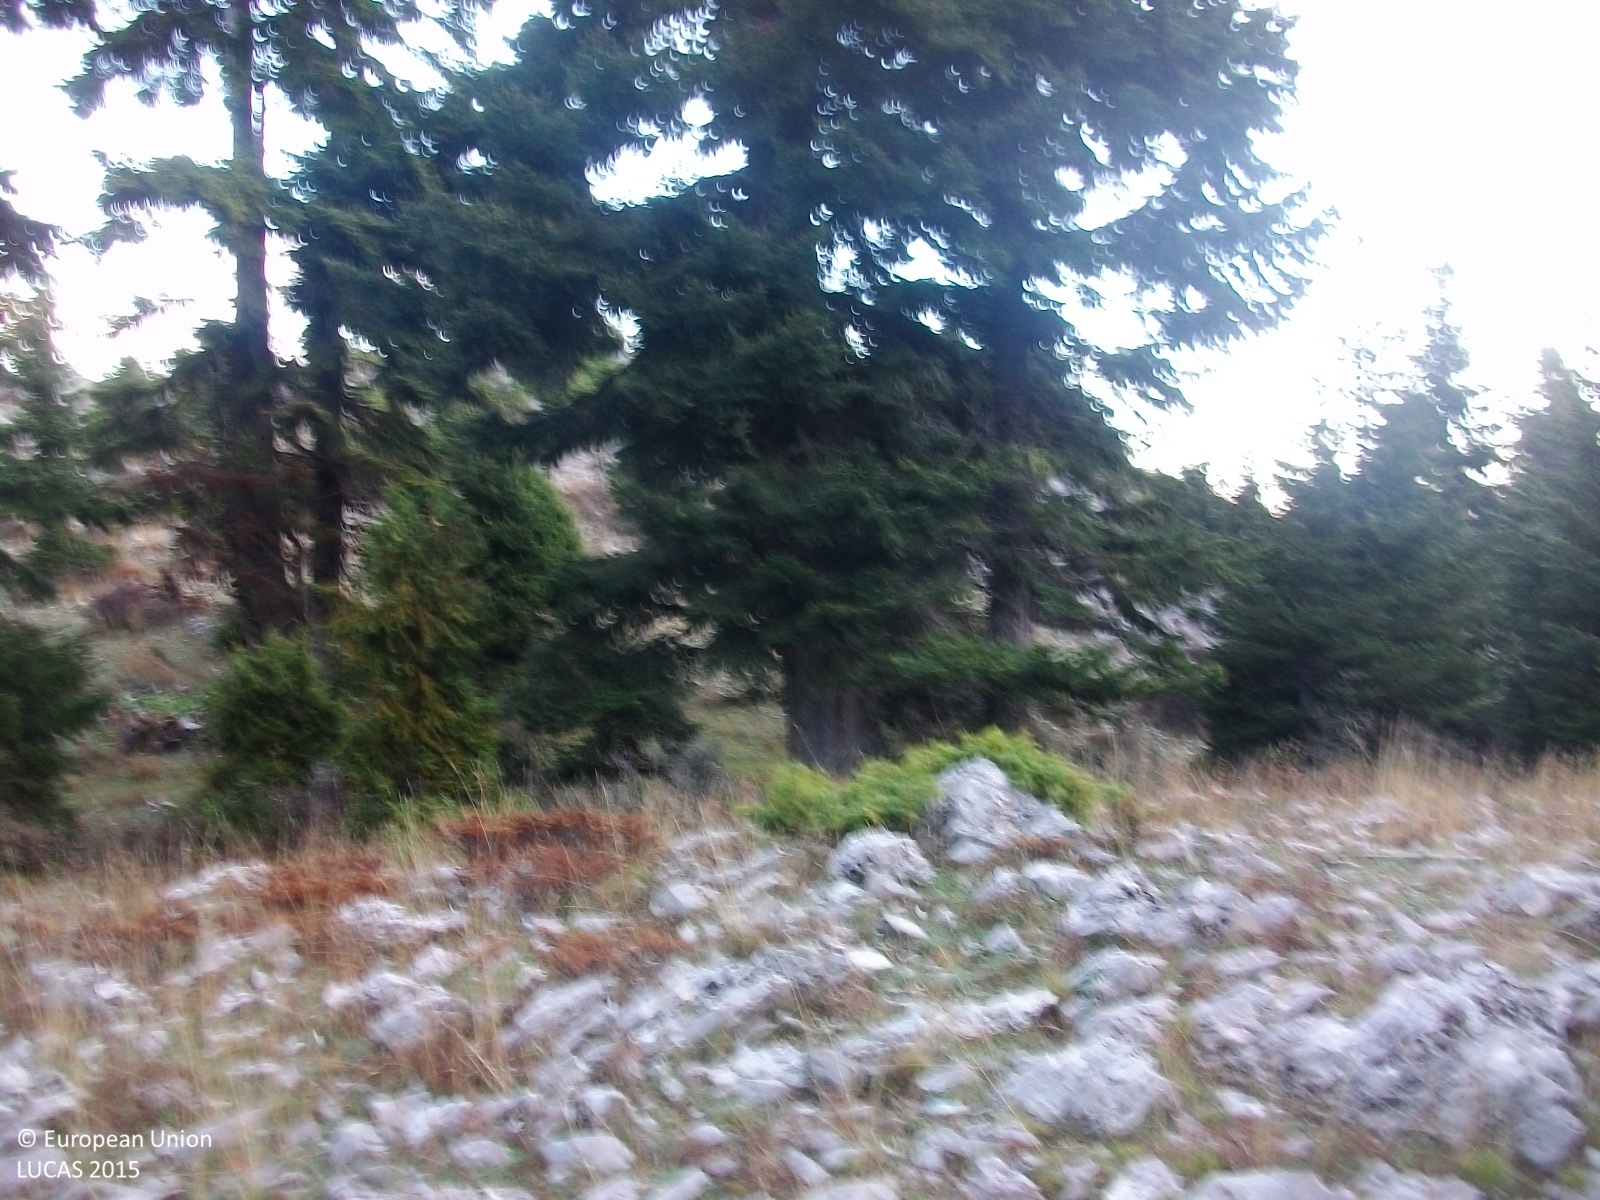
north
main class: Woodland
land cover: Spruce dominated coniferous woodland
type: coniferous forest of the mediterranean region
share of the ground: 10 - 25 %
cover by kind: unconsolidated bare surface 55 %, coniferous forest trees 30 %, consolidated bare surface 15 %
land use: Forestry
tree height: < 5 m
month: October
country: GR
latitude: 37.9367
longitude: 22.4272
